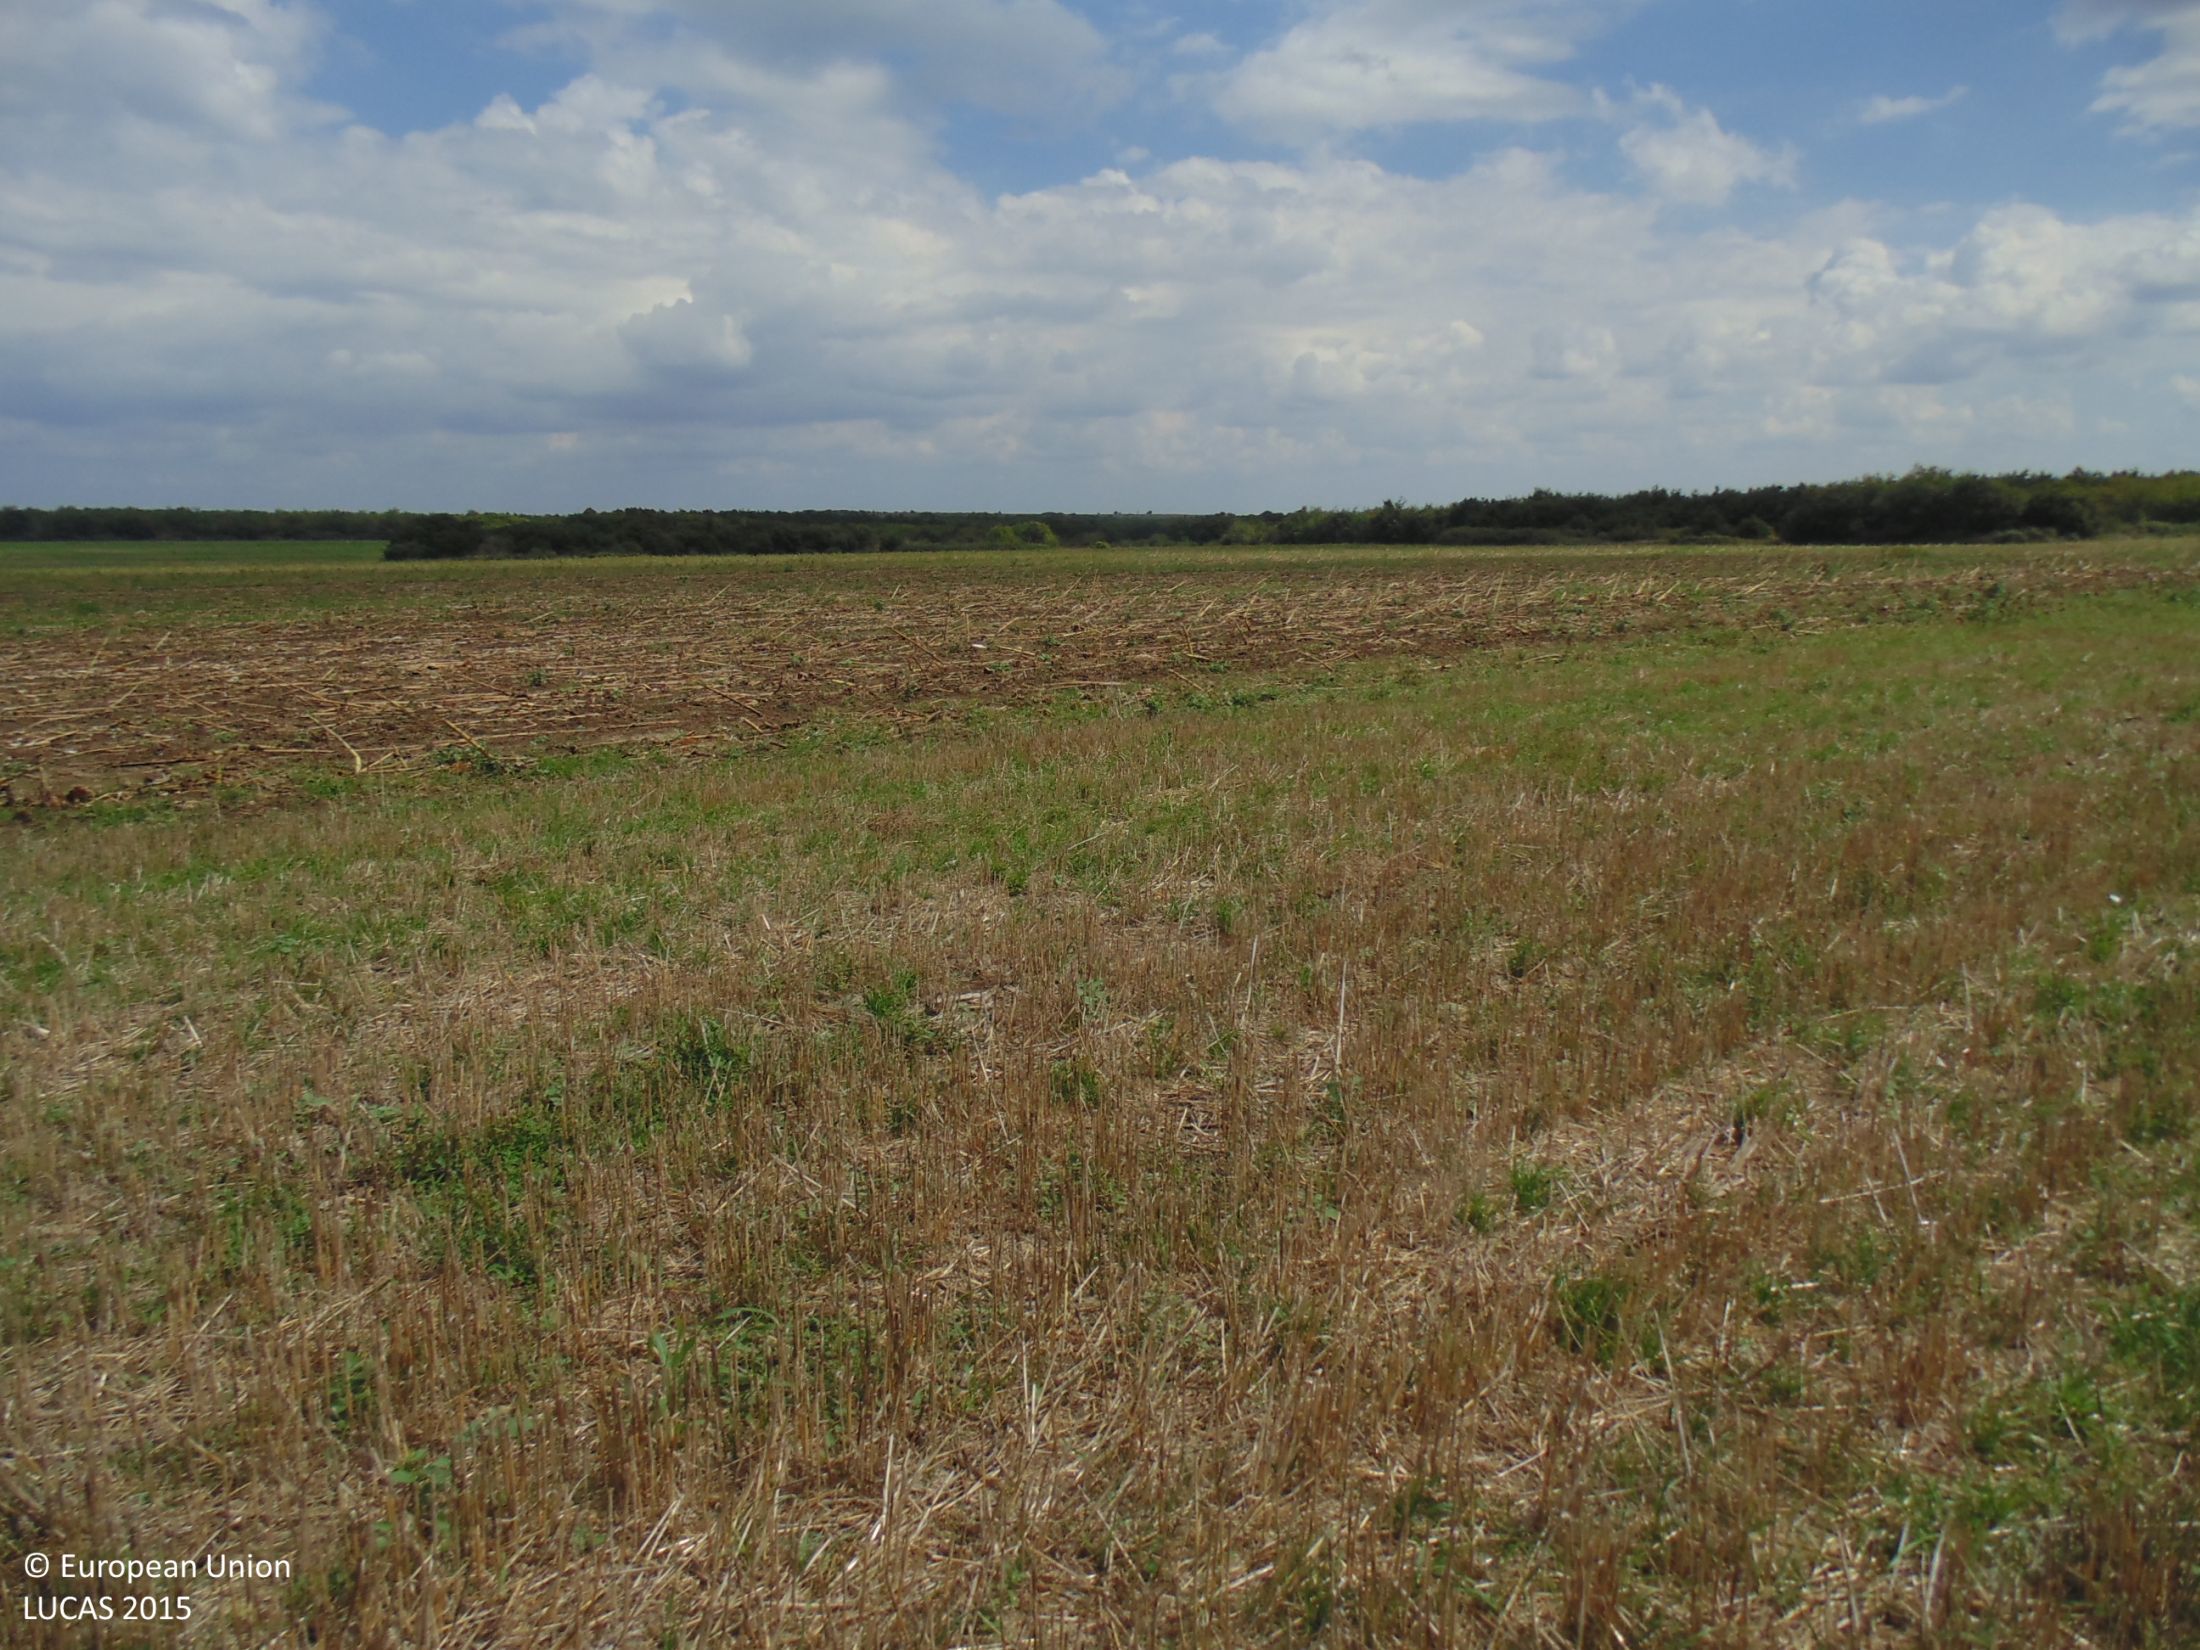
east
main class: Cropland
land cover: Common wheat
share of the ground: 25 - 50 %
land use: Agriculture (excluding fallow land and kitchen gardens)
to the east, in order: Common wheat; Grass margins; Sunflower
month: September
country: BG
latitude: 43.4127
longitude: 28.4736
